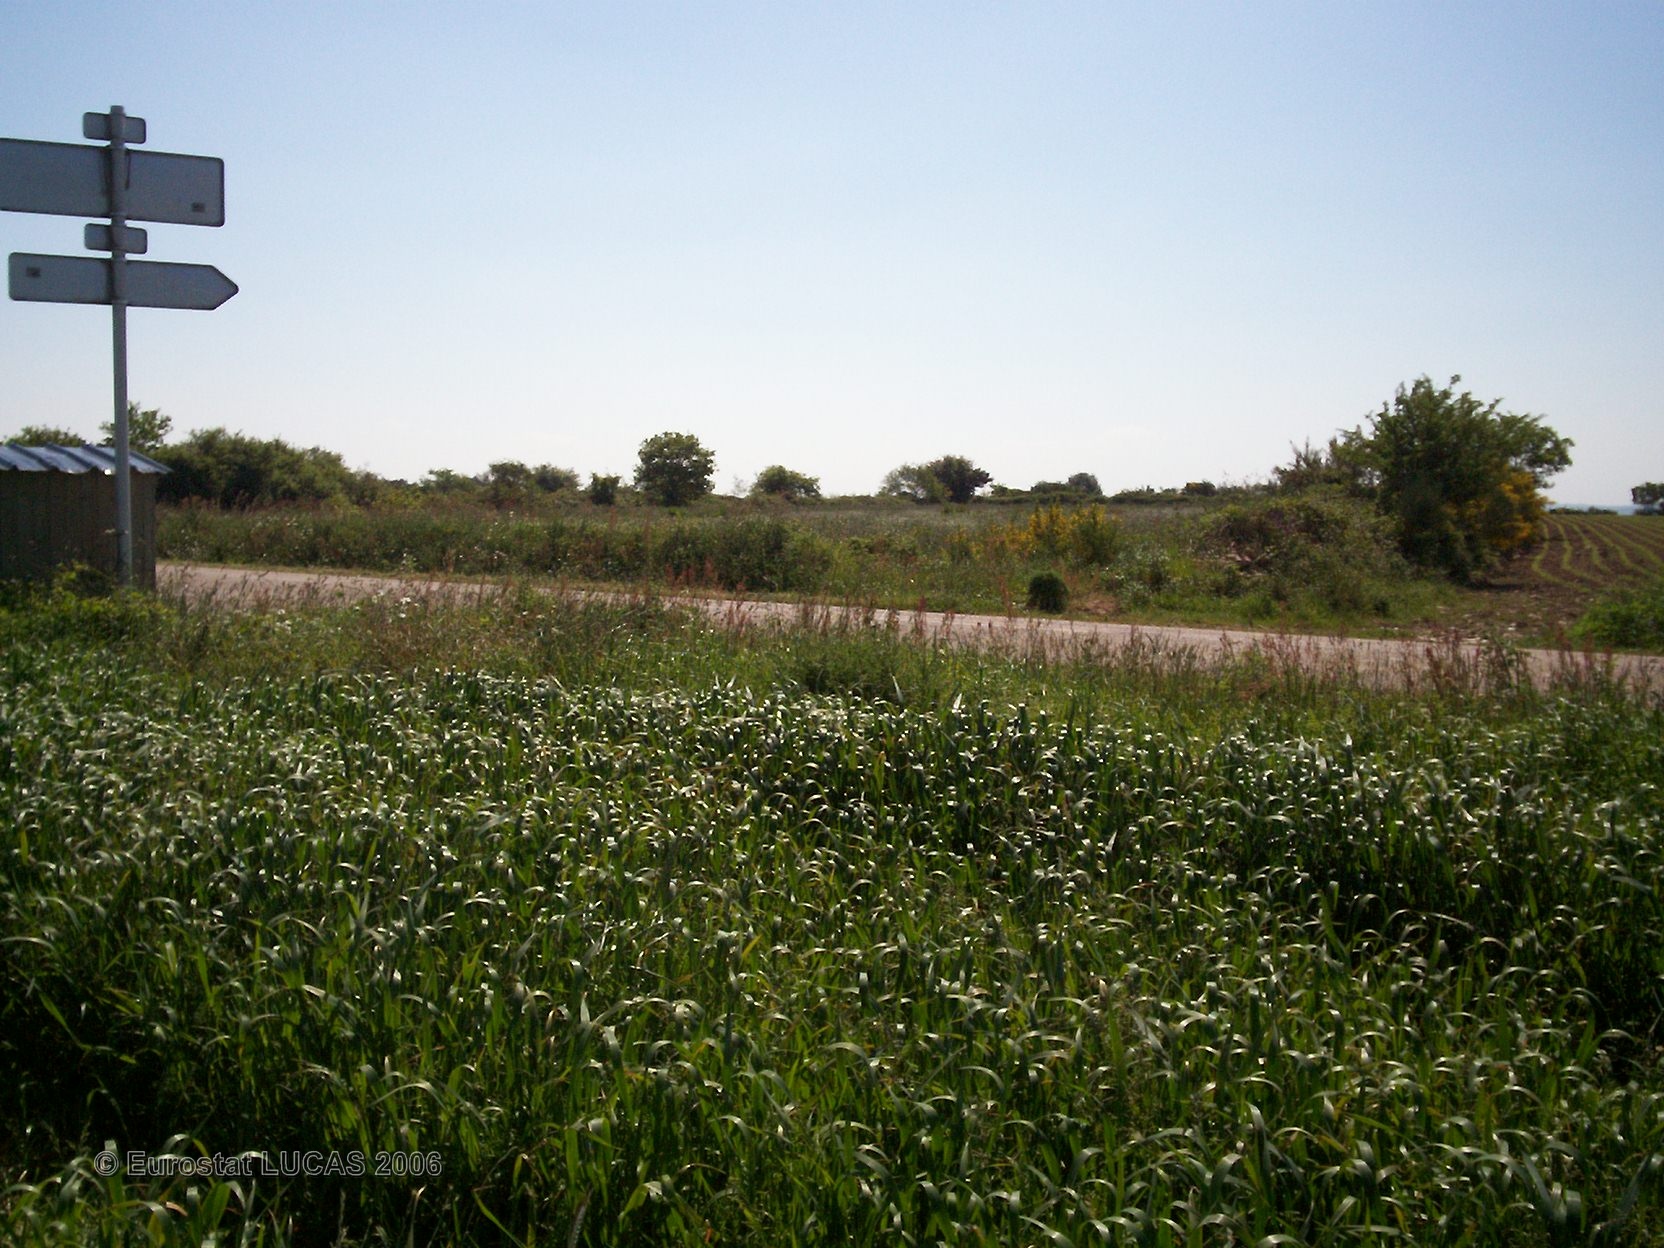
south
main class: Grassland
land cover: Grassland without tree/shrub cover
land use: Agriculture (excluding fallow land and kitchen gardens)
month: June
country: FR
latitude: 48.4648
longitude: -3.6465
